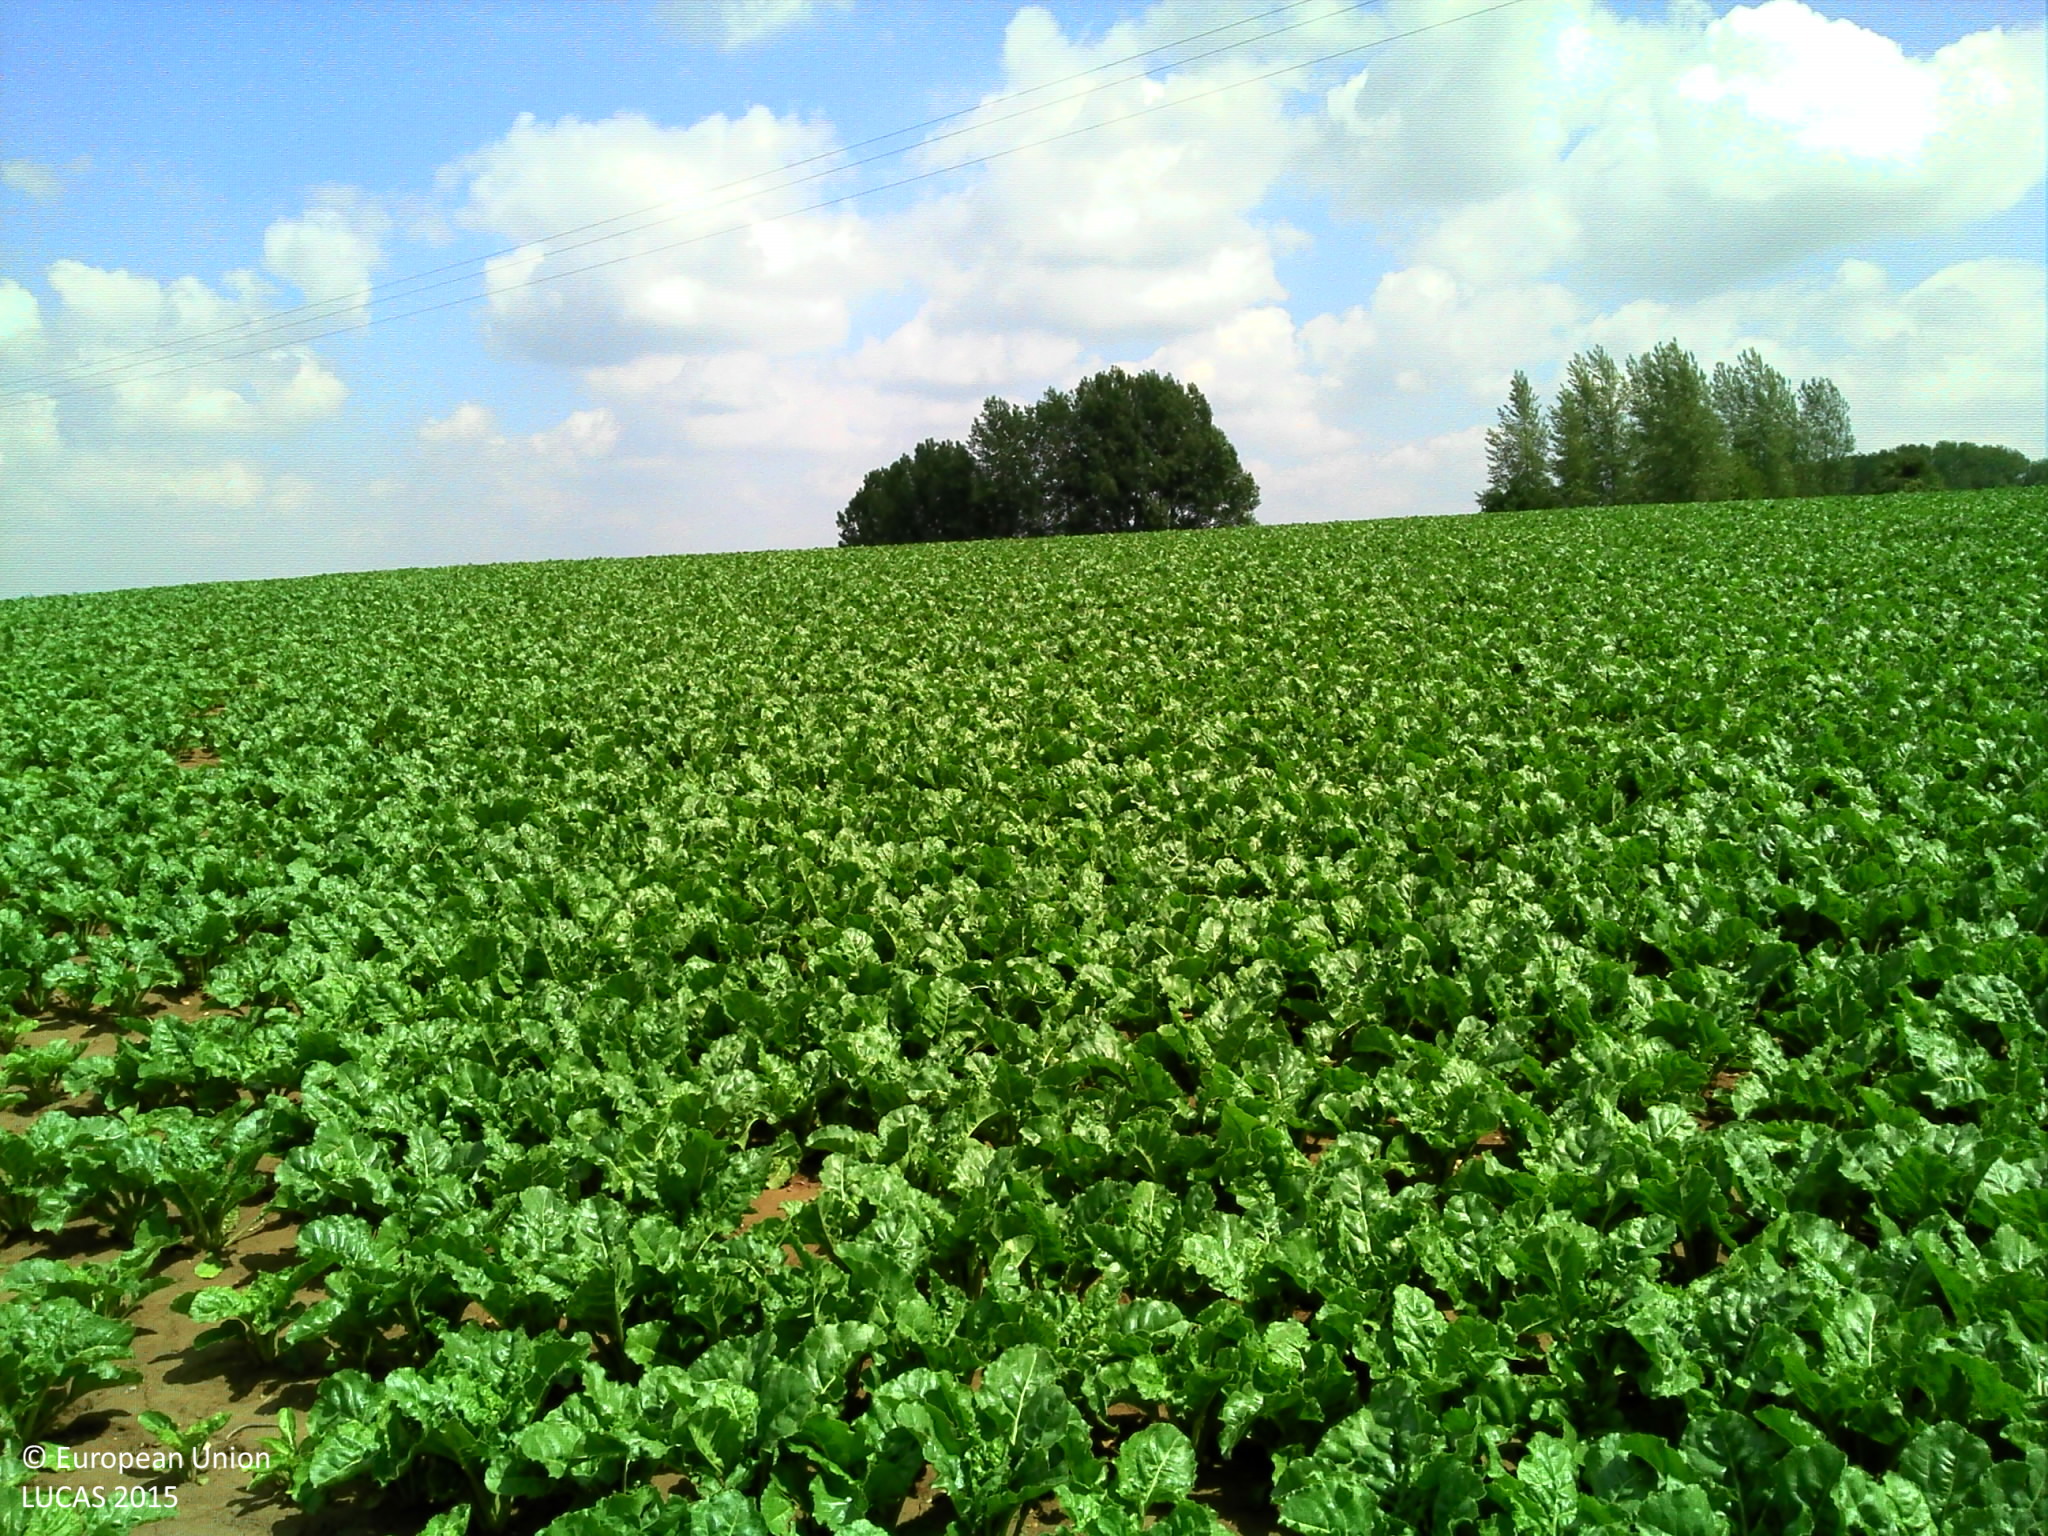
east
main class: Cropland
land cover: Sugar beet
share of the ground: 50 - 75 %
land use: Agriculture (excluding fallow land and kitchen gardens)
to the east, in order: Sugar beet; Electric lines; Sugar beet; Maize; Grass margins; Paved roads, cycling and walking lanes; Grass margins; Ditches and canals; Common wheat; Grass margins; Paved roads, cycling and walking lanes; Abandoned hedges; Fences; Spontaneously vegetated surfaces; Fences; Grass margins
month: June
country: BE
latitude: 50.6146
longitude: 3.8743
